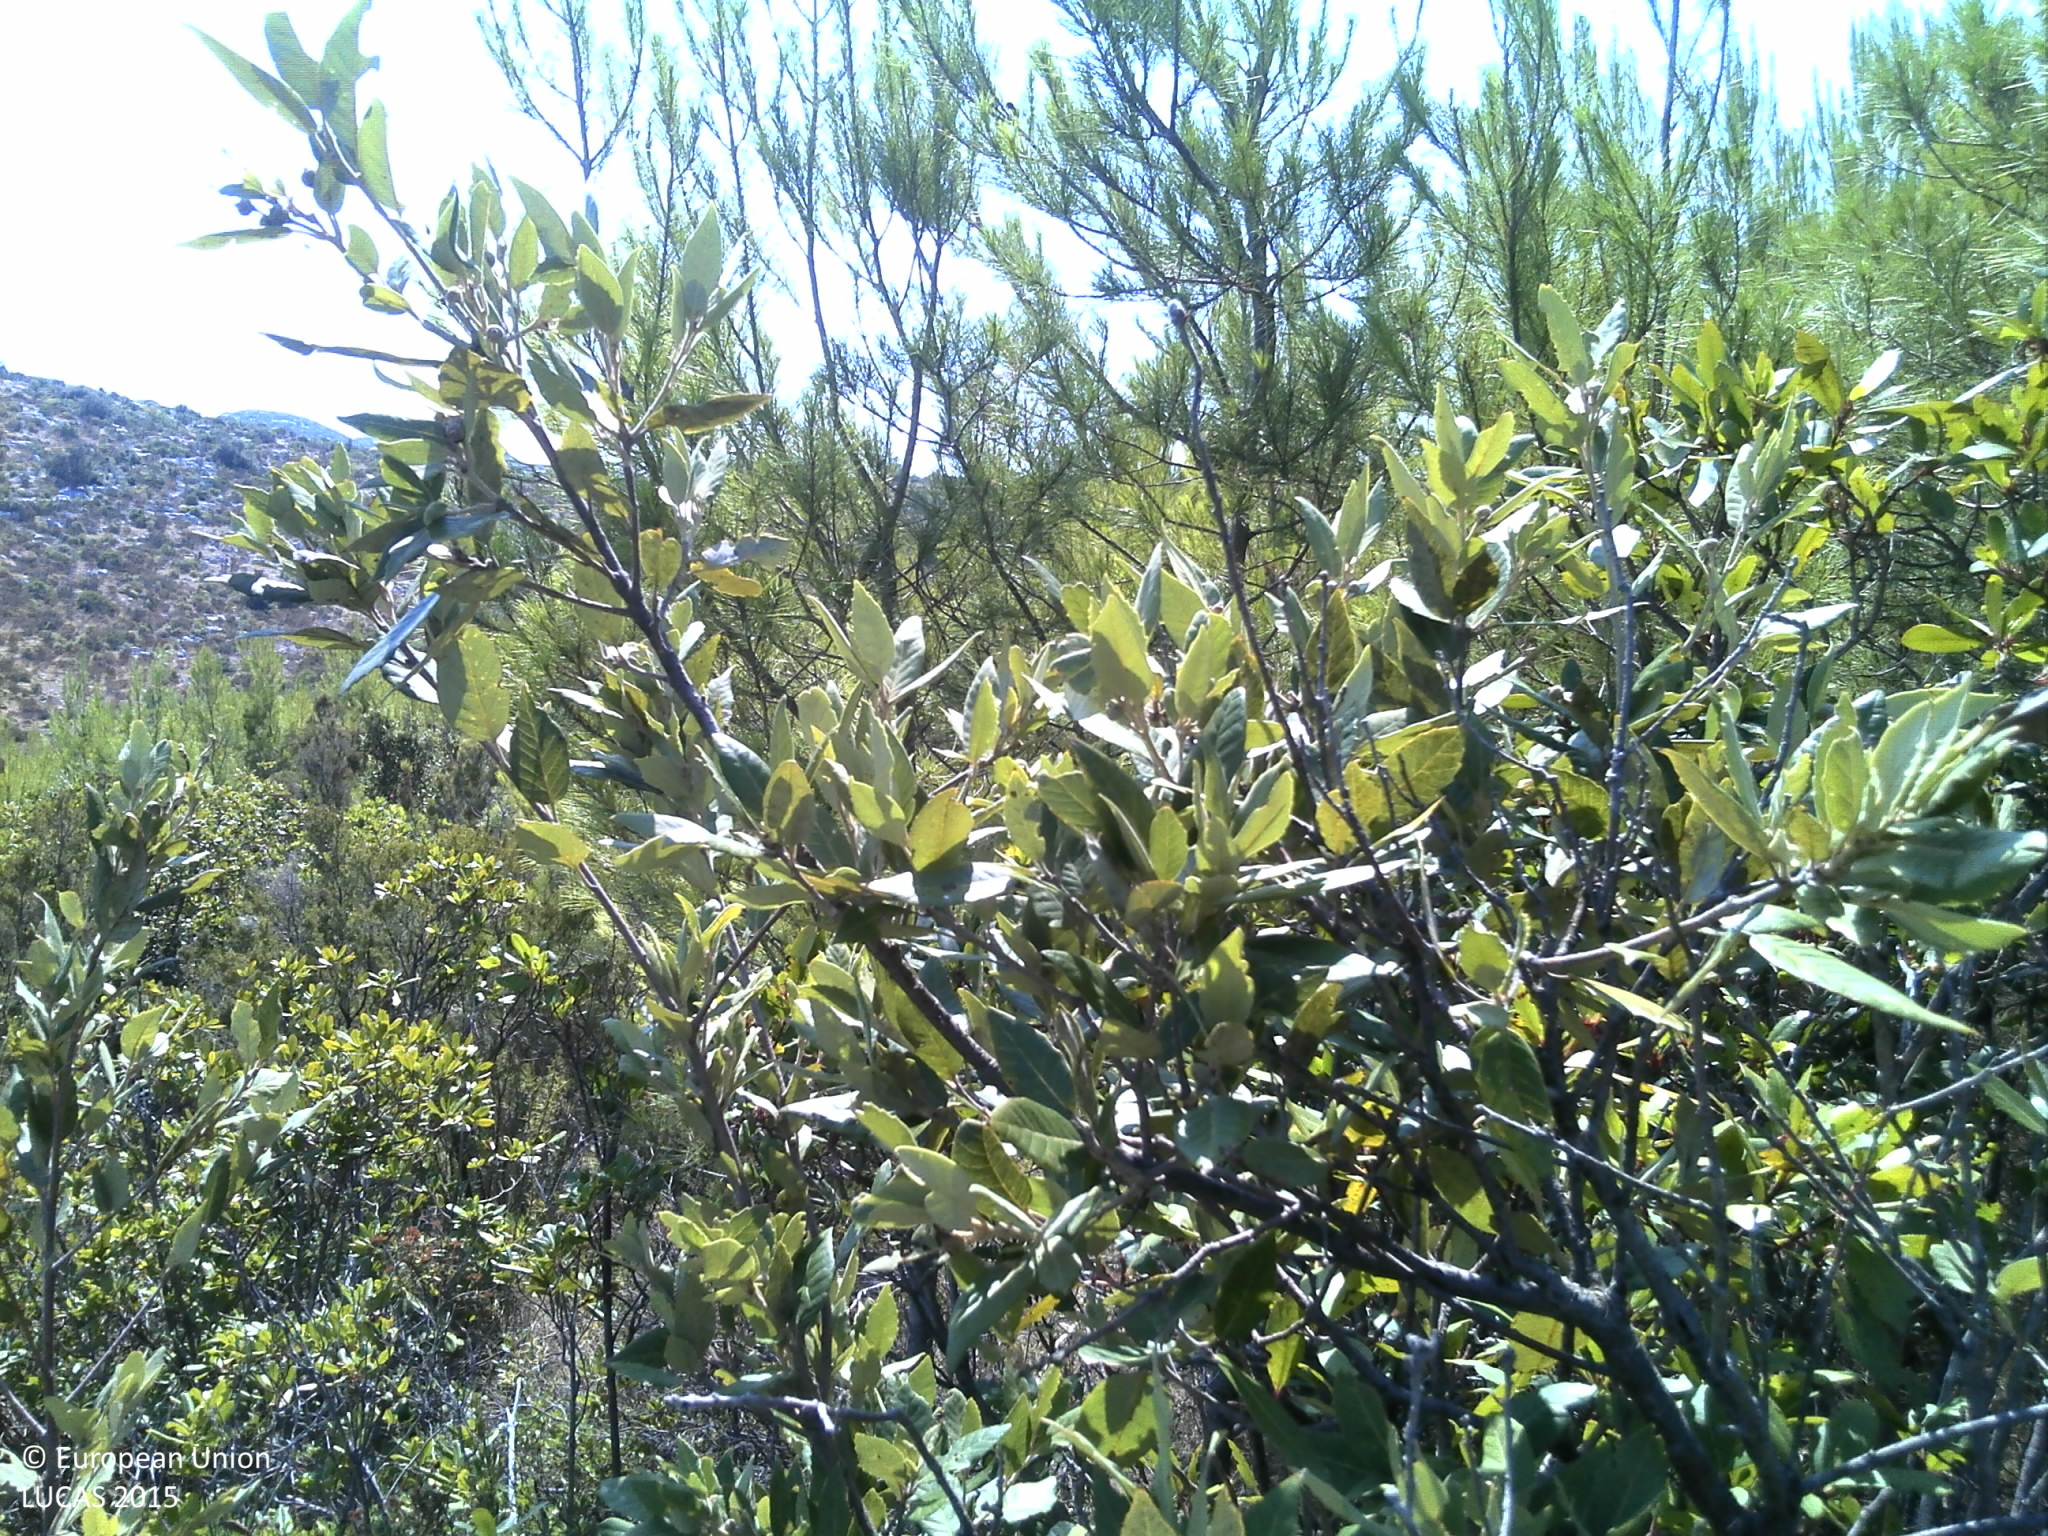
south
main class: Shrubland
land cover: Shrubland with sparse tree cover
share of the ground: 50 - 75 %
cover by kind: shrubs 70 %, herbaceous plants 15 %, coniferous forest trees 5 %, consolidated bare surface 5 %, unconsolidated bare surface 5 %
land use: Semi-natural and natural areas not in use
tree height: < 5 m
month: August
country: HR
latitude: 43.1908
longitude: 16.4495
